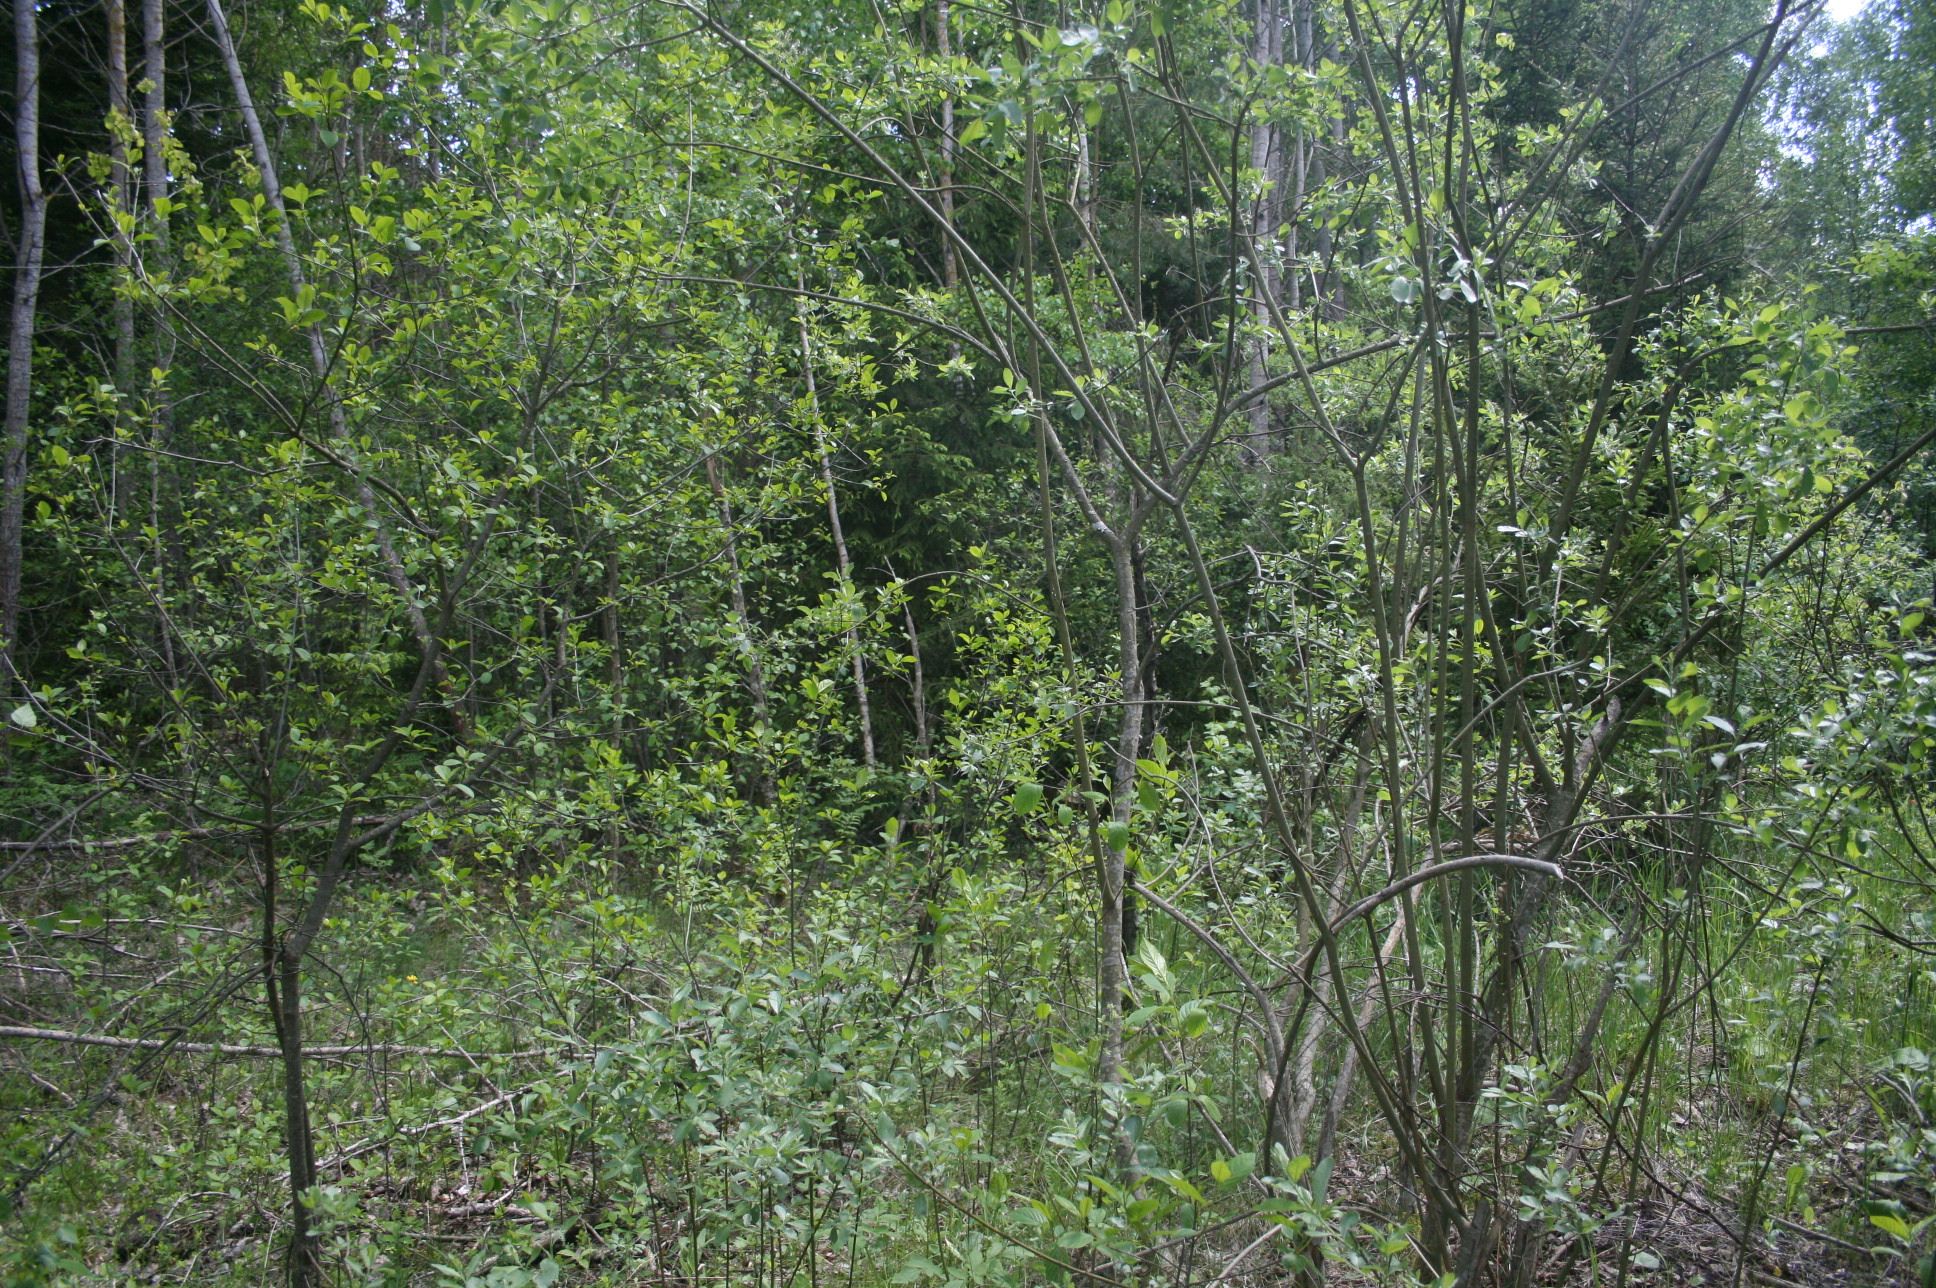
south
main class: Woodland
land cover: Broadleaved woodland
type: non-riverine alder, birch or aspen forest
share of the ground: > 75 %
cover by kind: broadleaved forest trees 85 %, herbaceous plants 10 %, coniferous forest trees 5 %
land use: Forestry
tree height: > 5 m
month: June
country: LT
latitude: 56.0802
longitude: 22.3485
